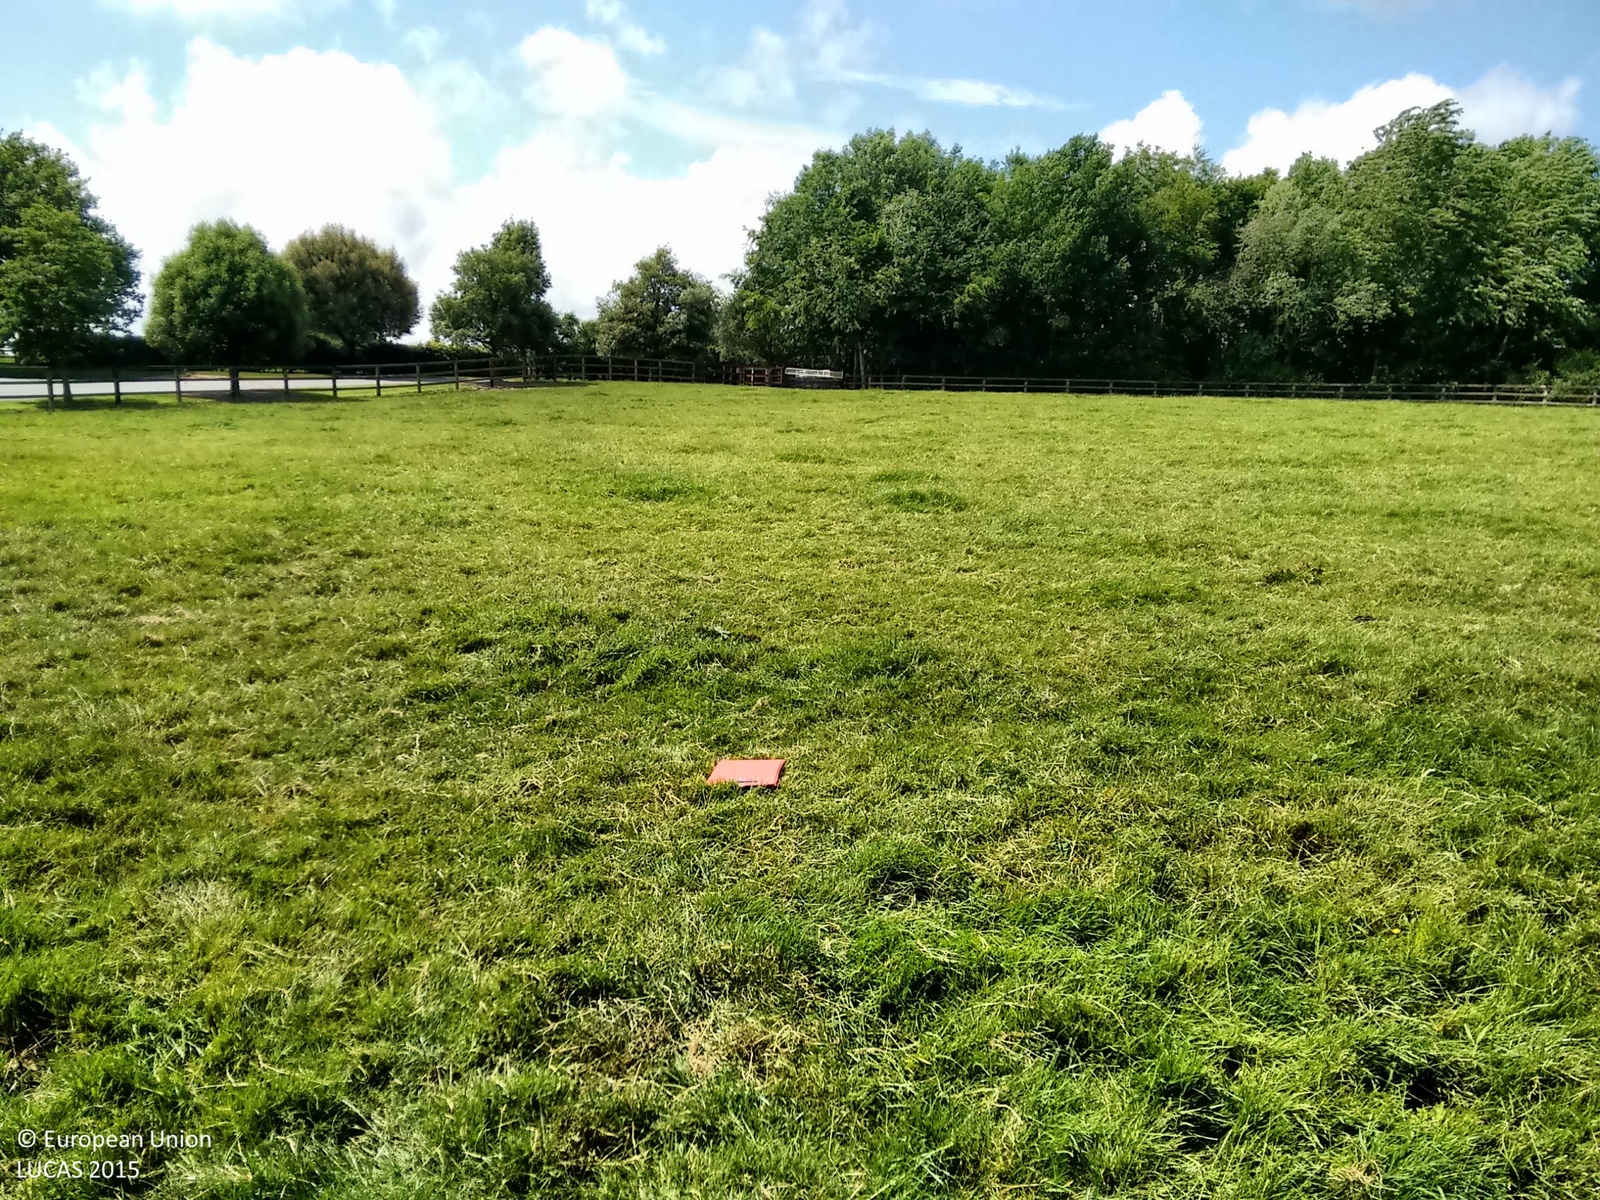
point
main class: Grassland
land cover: Grassland without tree/shrub cover
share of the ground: > 75 %
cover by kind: herbaceous plants 100 %
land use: Agriculture (excluding fallow land and kitchen gardens)
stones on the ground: < 10 %
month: July
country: IE
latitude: 52.4915
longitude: -7.6764
